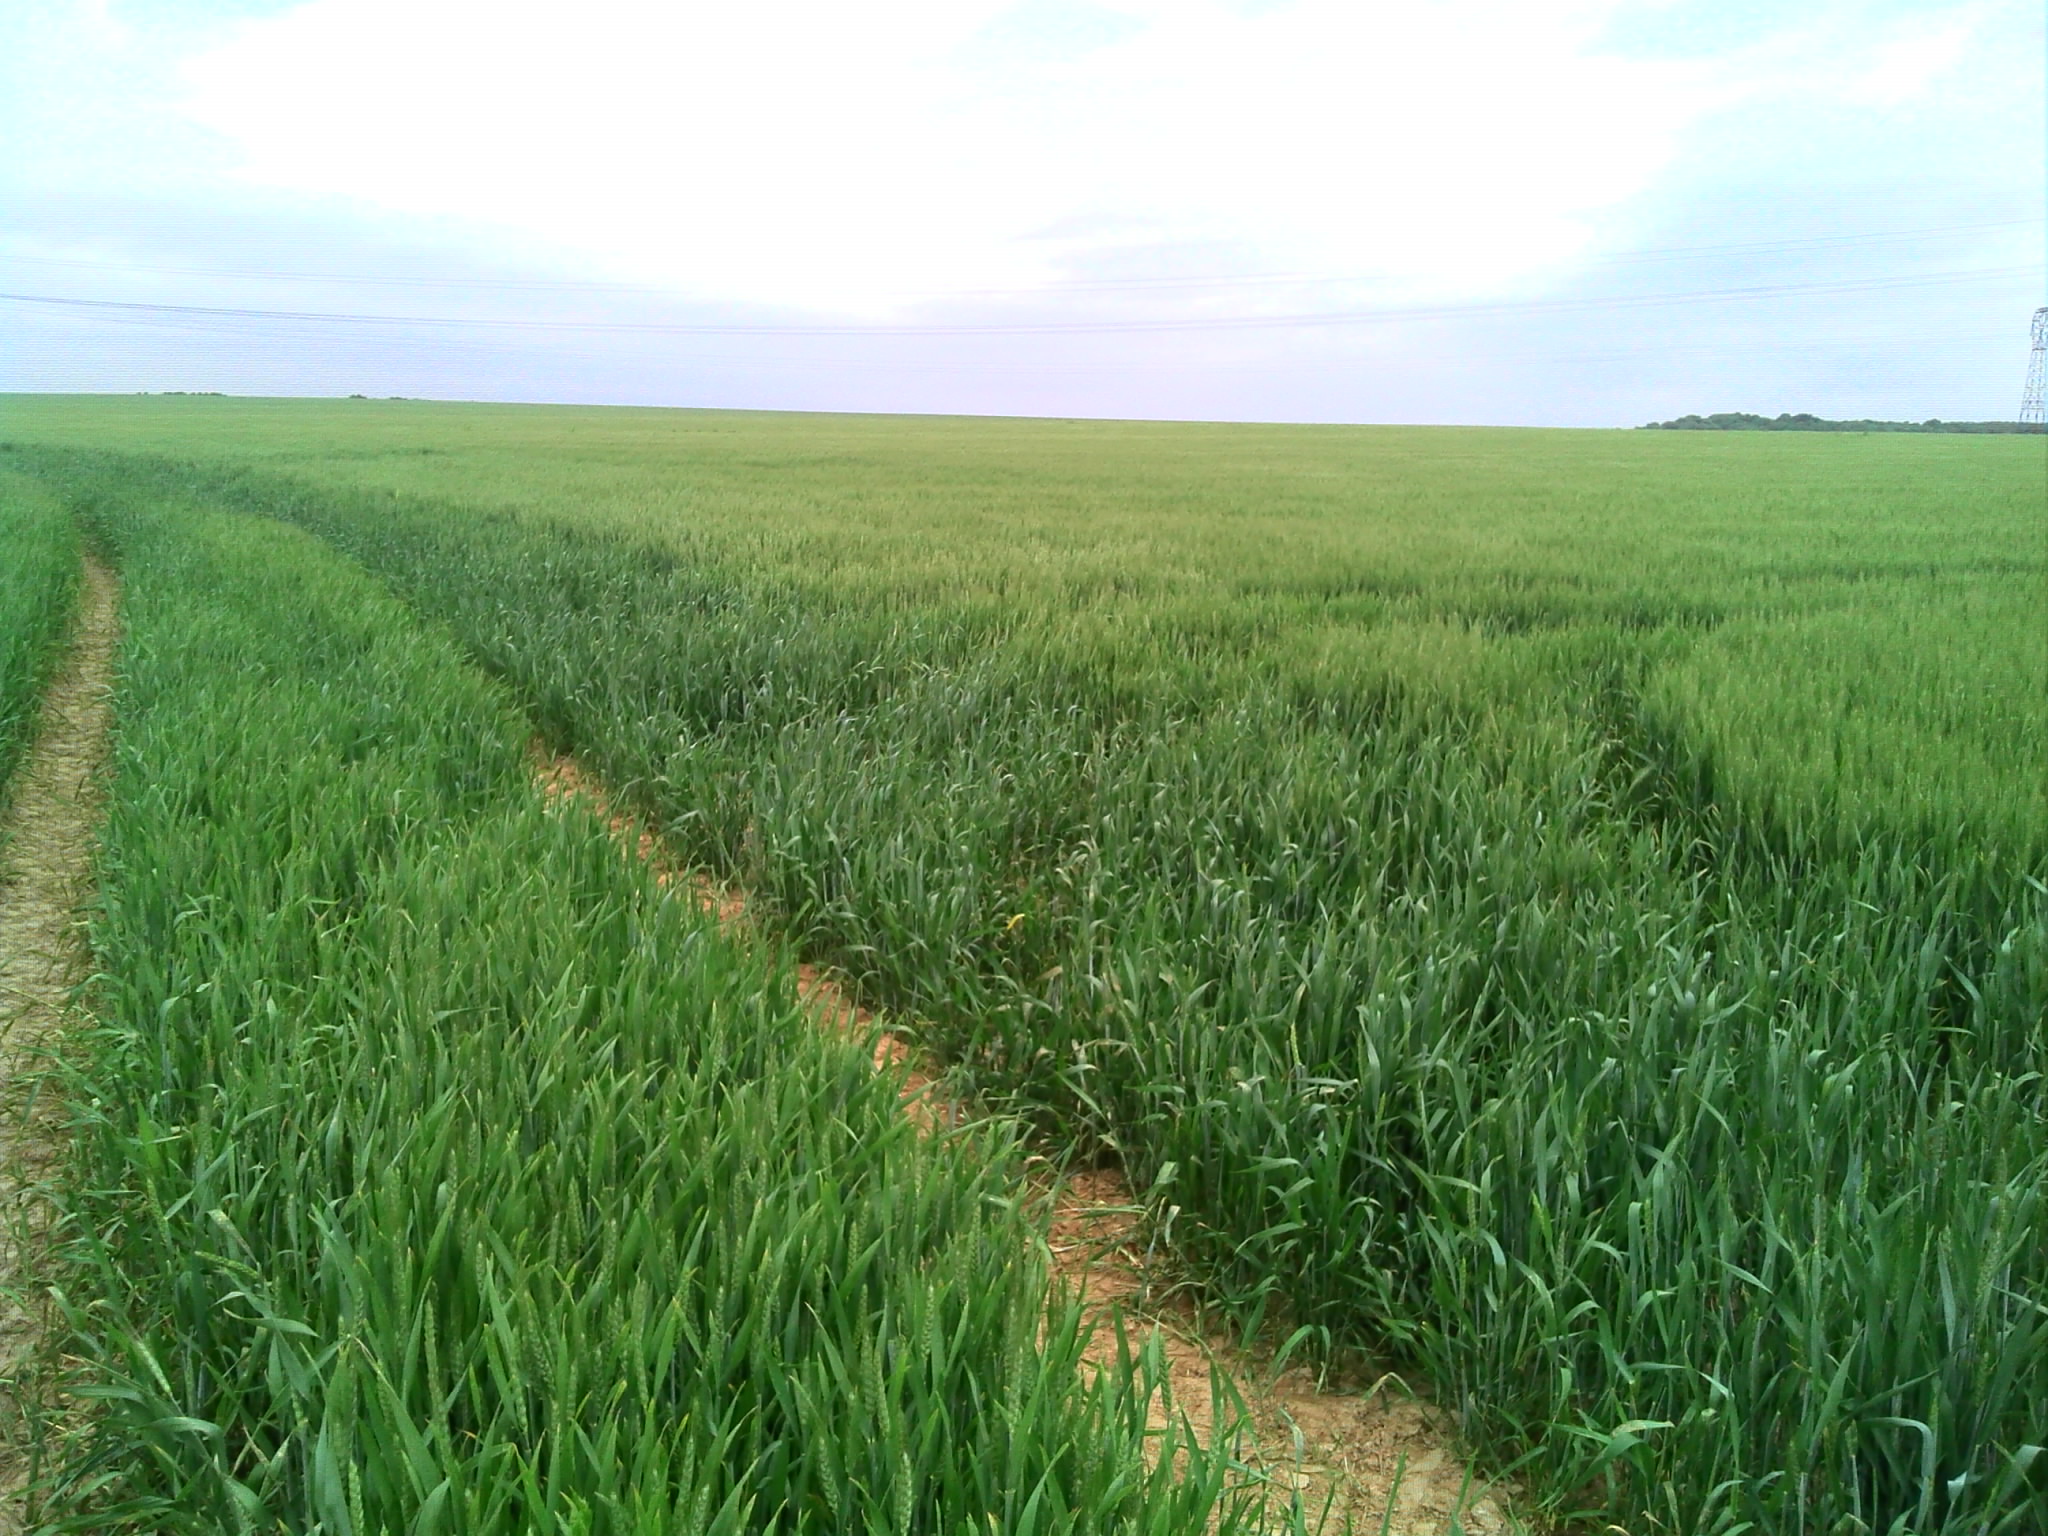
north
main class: Cropland
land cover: Common wheat
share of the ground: > 75 %
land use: Agriculture (excluding fallow land and kitchen gardens)
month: June
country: FR
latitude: 49.6395
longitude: 3.2201
